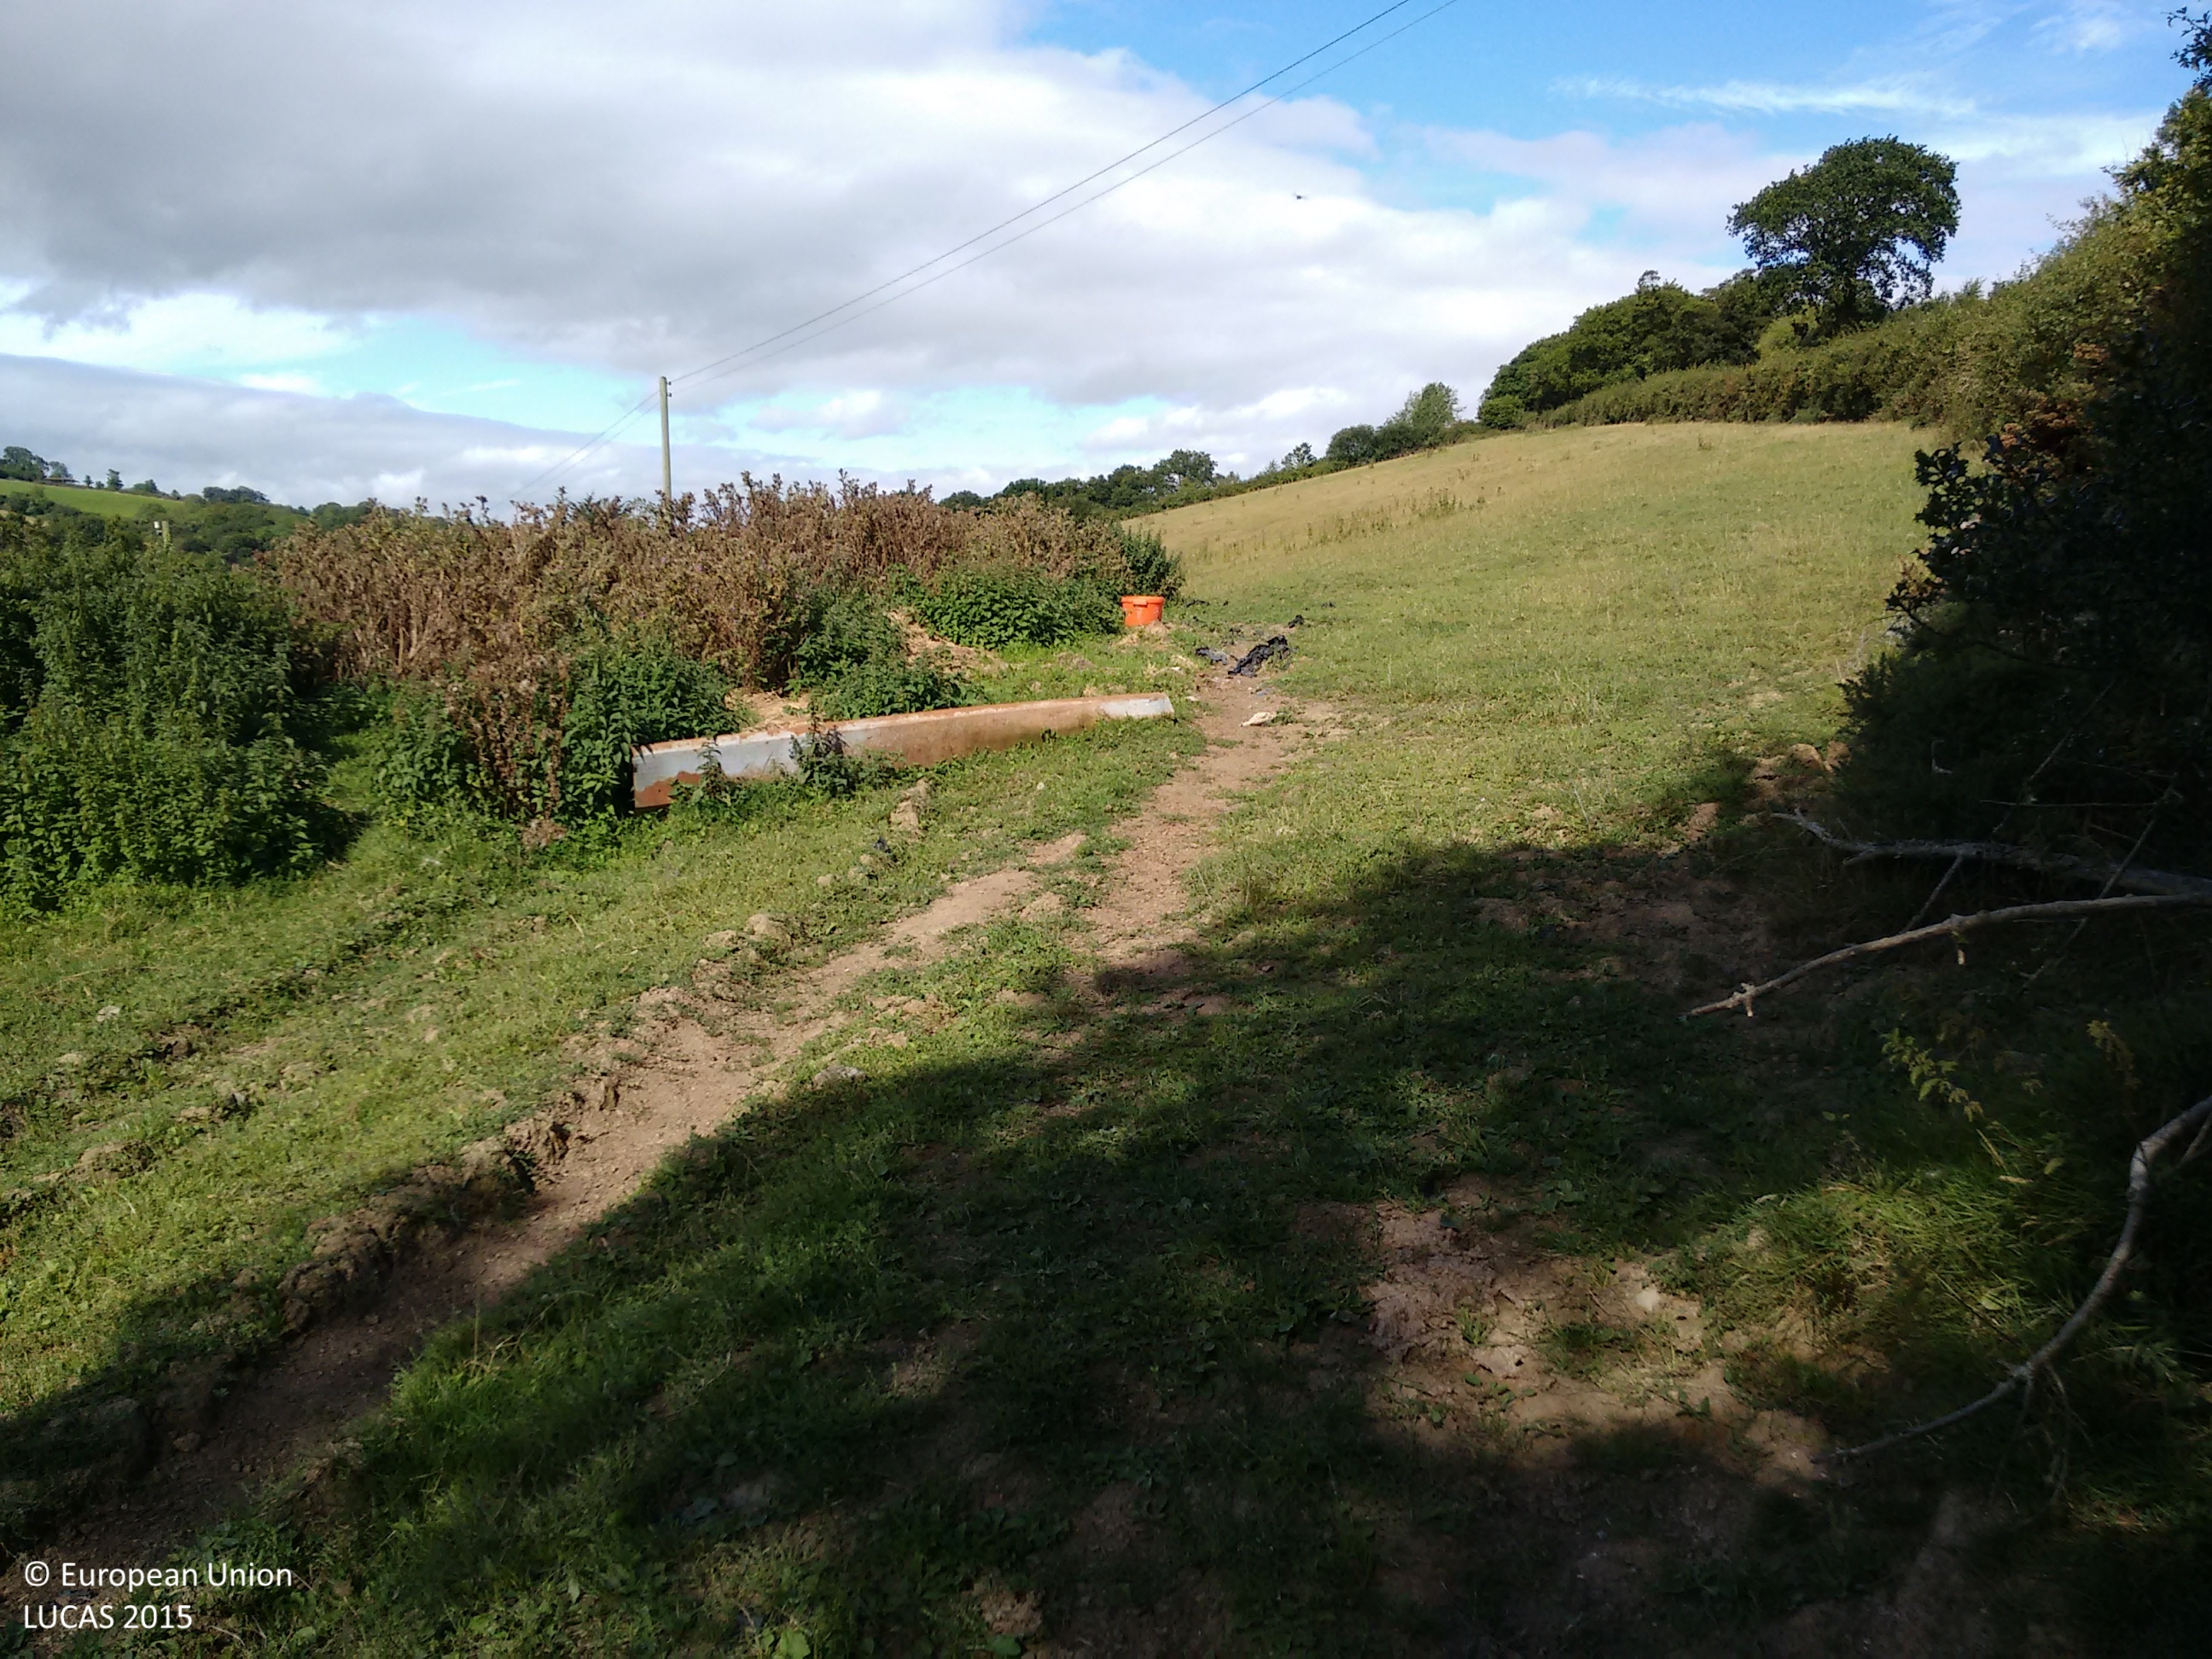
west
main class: Grassland
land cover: Grassland without tree/shrub cover
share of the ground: > 75 %
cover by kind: herbaceous plants 100 %
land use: Agriculture (excluding fallow land and kitchen gardens)
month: August
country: GB
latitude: 50.7339
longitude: -3.5884
